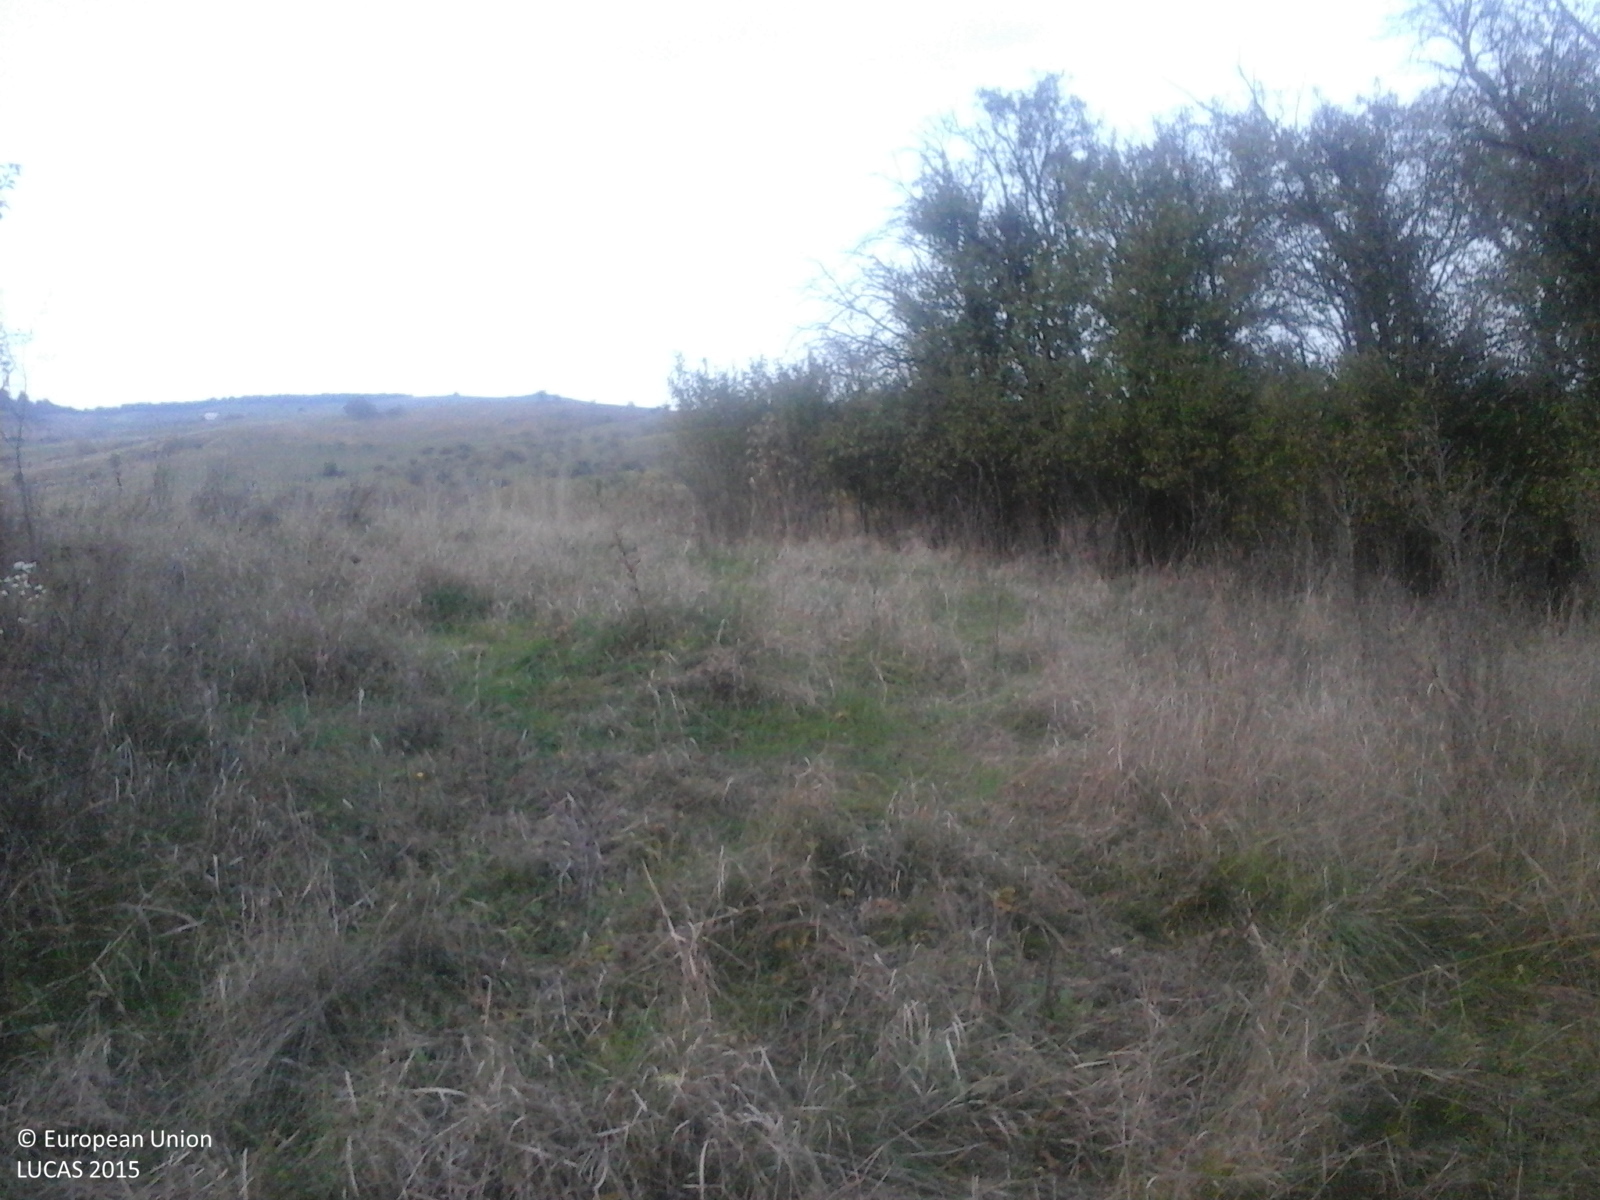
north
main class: Grassland
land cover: Grassland with sparse tree/shrub cover
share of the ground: > 75 %
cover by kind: herbaceous plants 95 %, broadleaved forest trees 5 %
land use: Fallow land
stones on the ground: < 10 %
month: October
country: RO
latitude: 46.1947
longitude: 25.3016
